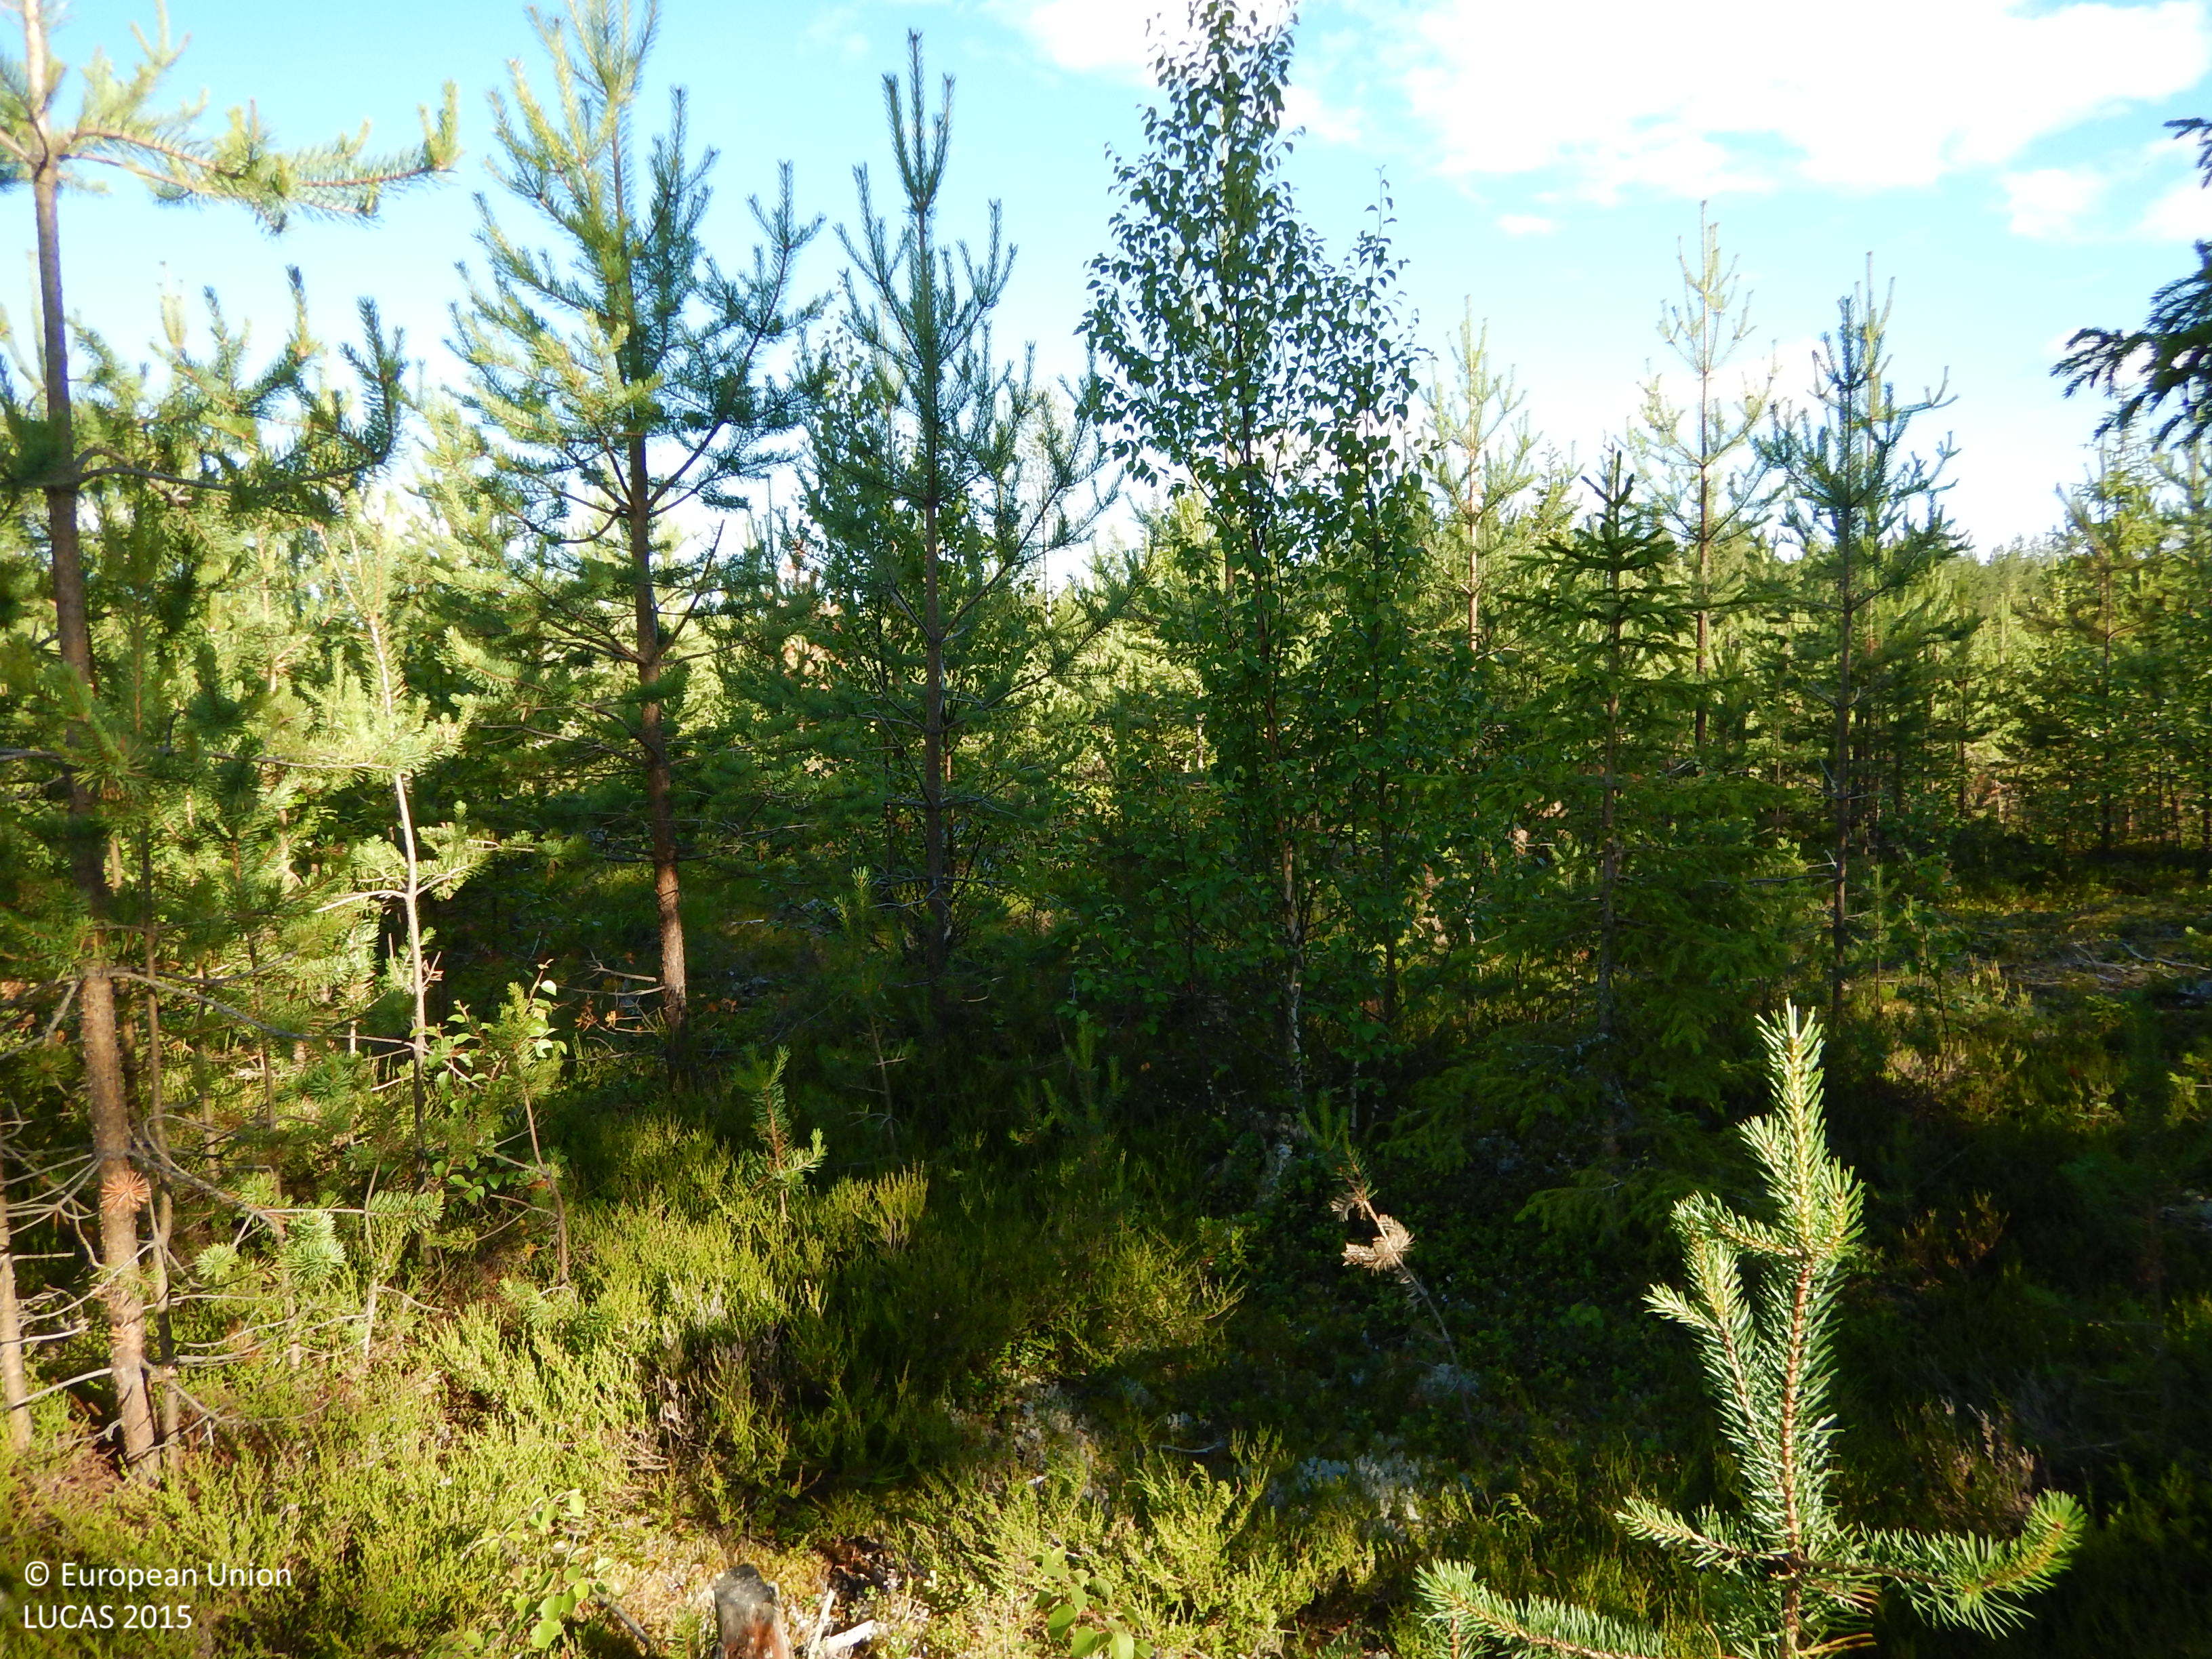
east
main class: Woodland
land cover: Pine dominated mixed woodland
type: boreal forest
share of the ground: 25 - 50 %
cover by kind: coniferous forest trees 25 %, shrubs 25 %, broadleaved forest trees 20 %, herbaceous plants 20 %, lichens and mosses 10 %
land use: Forestry
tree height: < 5 m
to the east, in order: Pine dominated mixed woodland; Pine dominated coniferous woodland; Ditches and canals; Shruby margins; Paved roads, cycling and walking lanes; Shruby margins; Ditches and canals; Broadleaved woodland; Ditches and canals; Other mixed woodland
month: July
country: SE
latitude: 64.8071
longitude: 20.9046
